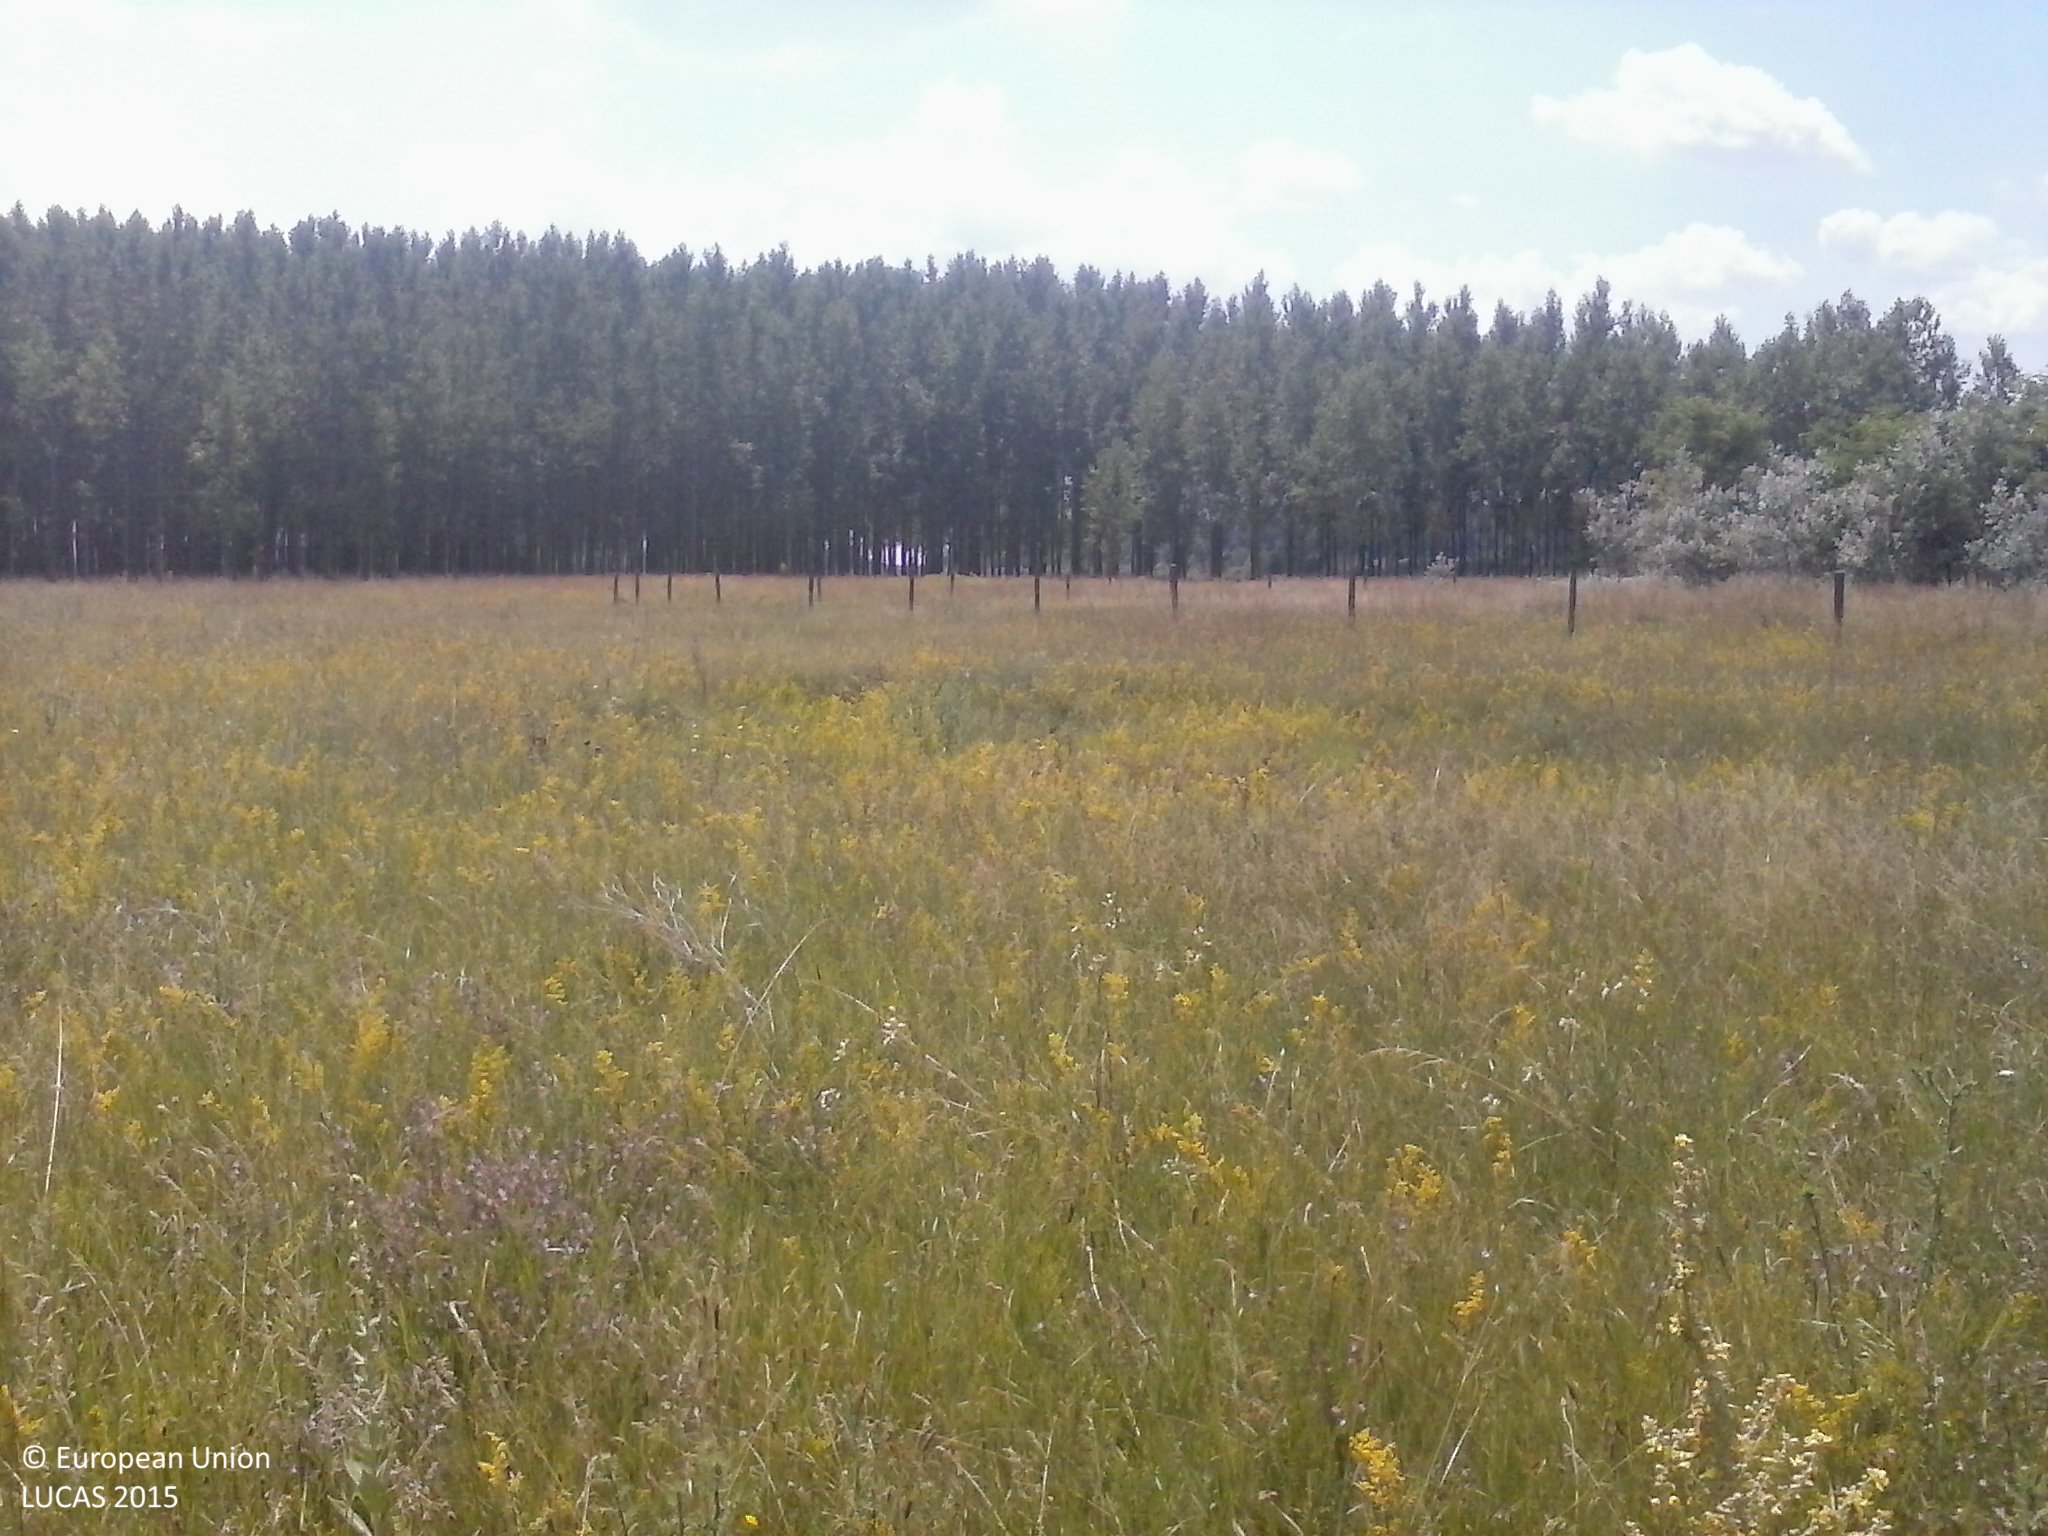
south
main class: Grassland
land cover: Grassland without tree/shrub cover
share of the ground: > 75 %
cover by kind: herbaceous plants 100 %
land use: Agriculture (excluding fallow land and kitchen gardens)
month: July
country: HU
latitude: 46.3230
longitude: 19.5373
